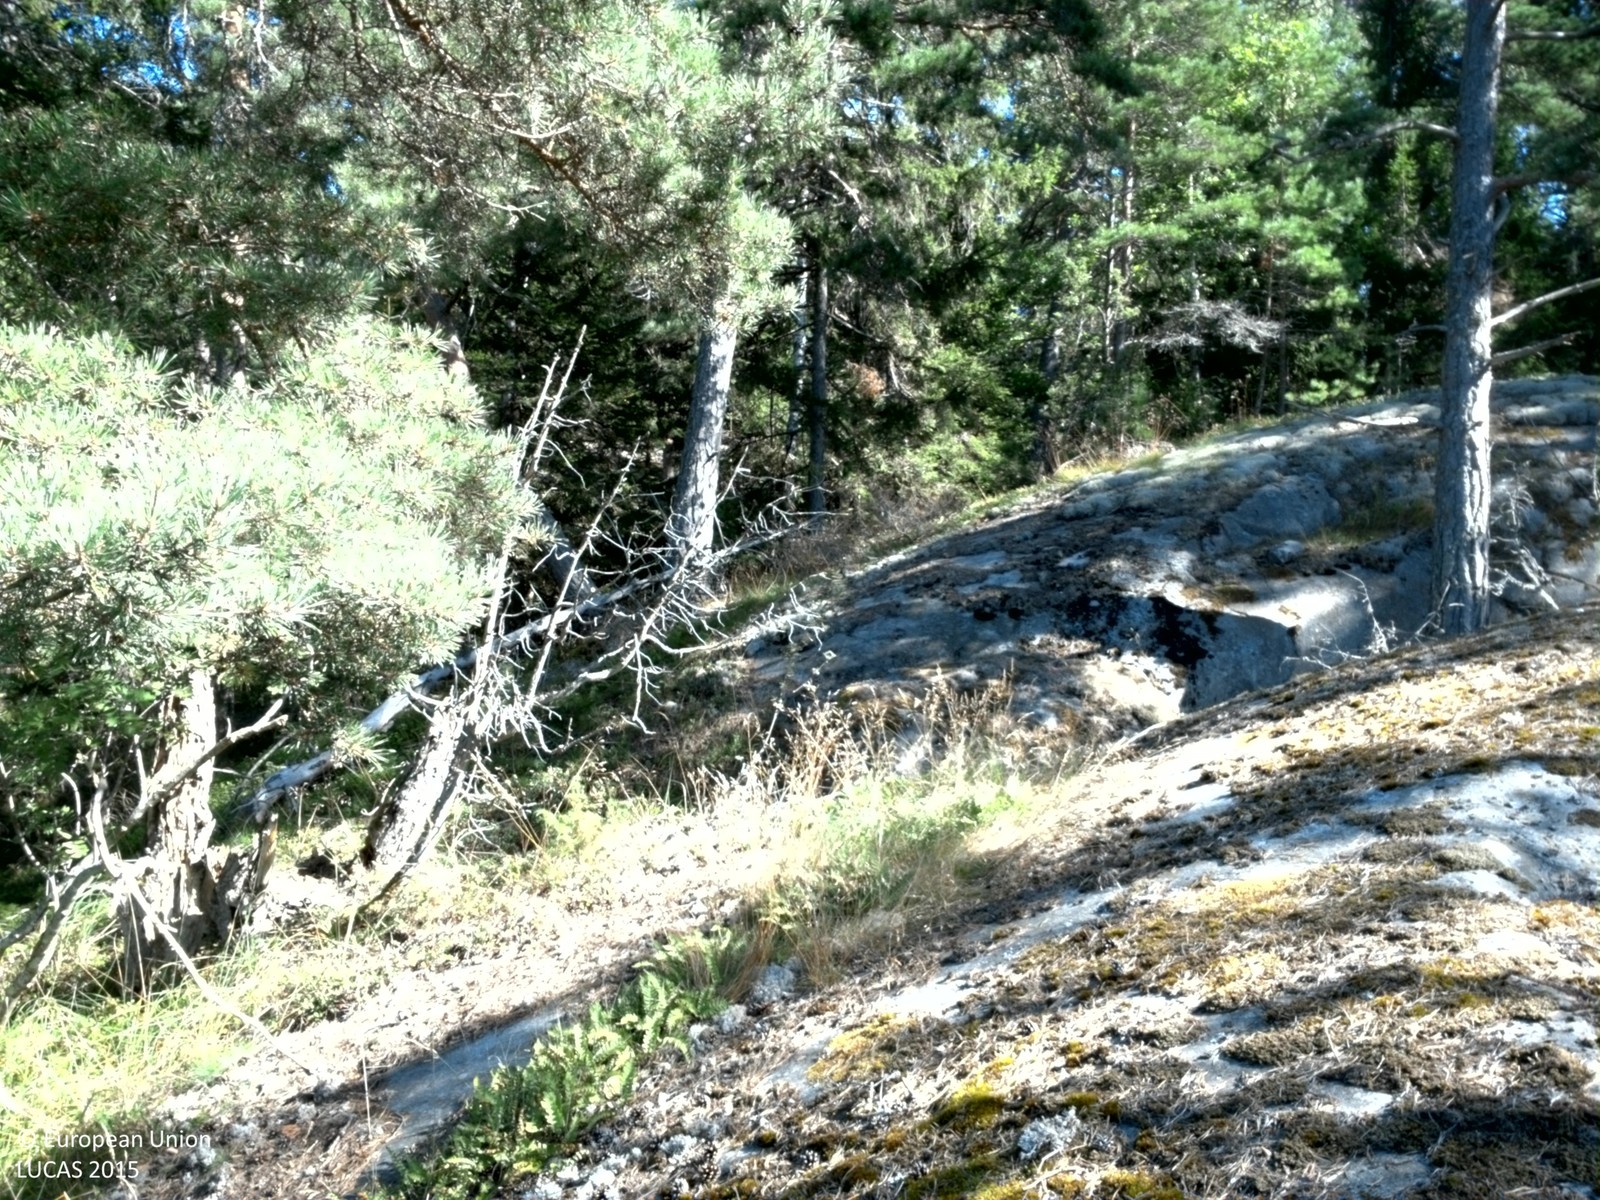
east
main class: Woodland
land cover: Other coniferous woodland
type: boreal forest
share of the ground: 50 - 75 %
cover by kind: coniferous forest trees 45 %, consolidated bare surface 30 %, lichens and mosses 20 %, broadleaved forest trees 5 %
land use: Forestry
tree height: > 5 m
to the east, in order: Other coniferous woodland; Spruce dominated coniferous woodland; Other coniferous woodland; Tracks; Pine dominated coniferous woodland
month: August
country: SE
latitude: 59.5969
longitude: 18.8058
